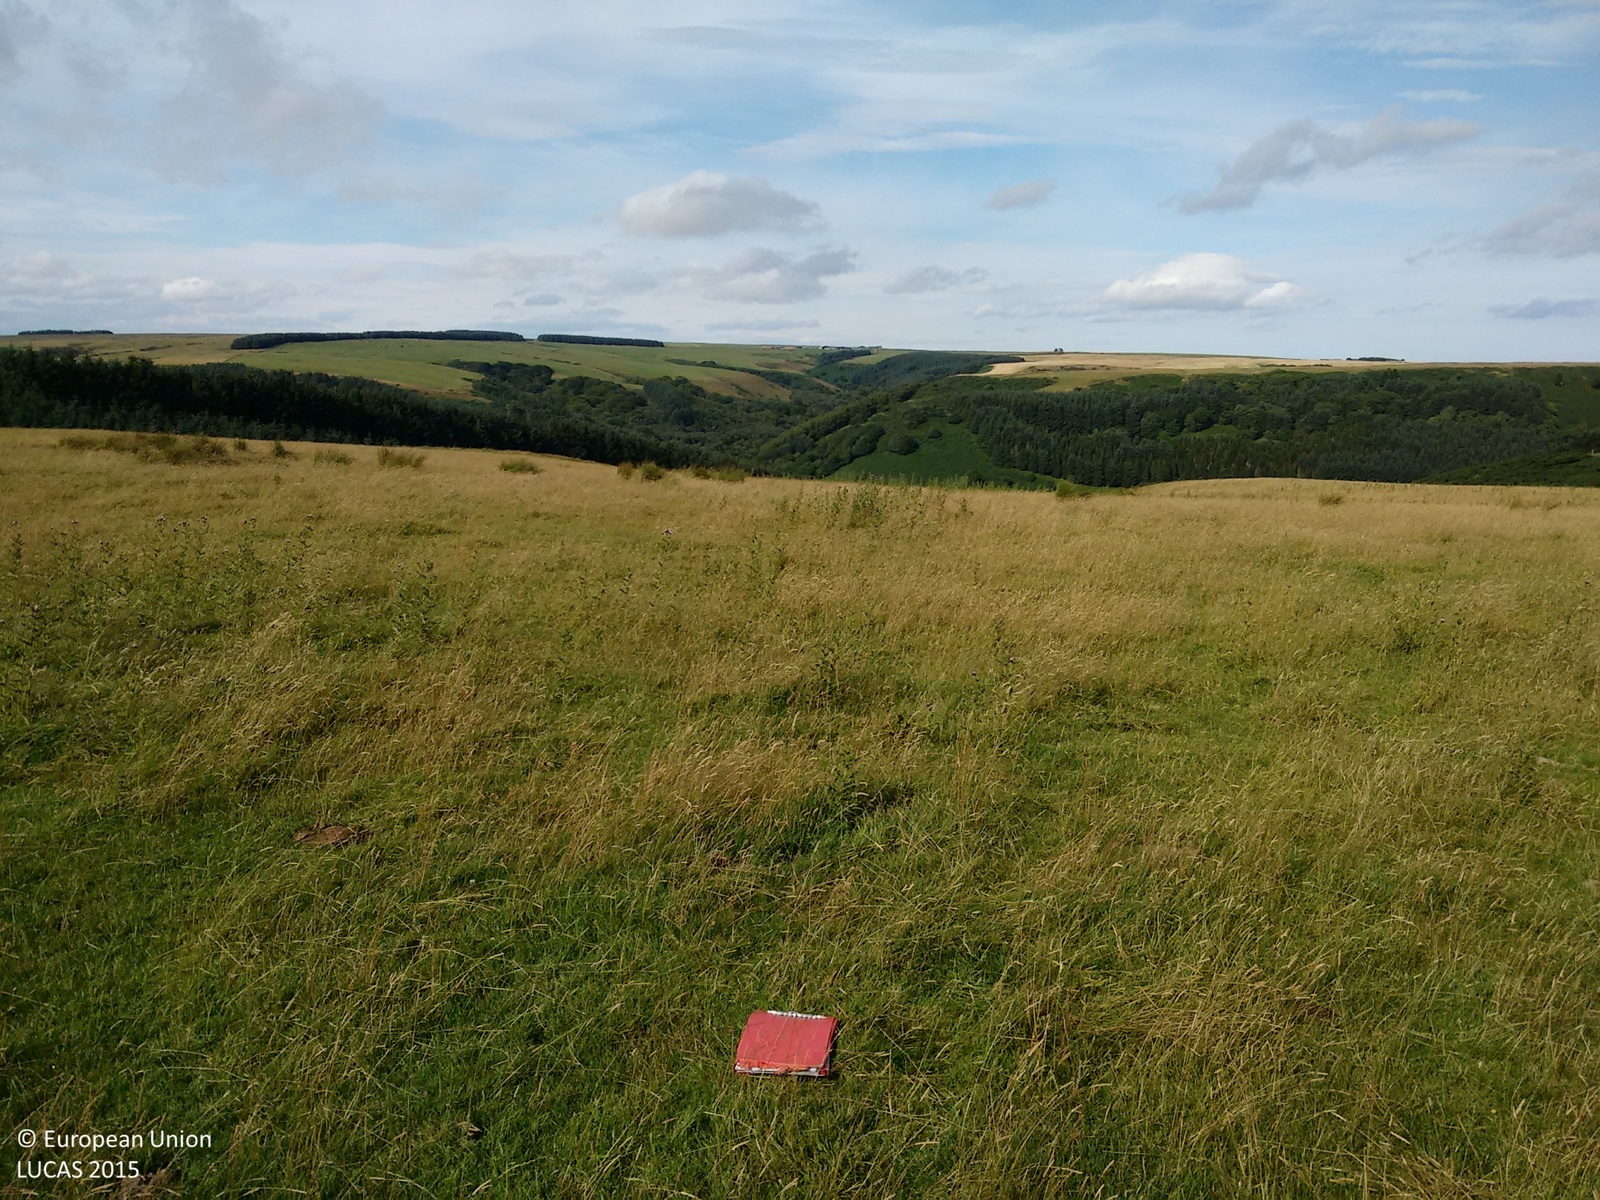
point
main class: Grassland
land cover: Grassland without tree/shrub cover
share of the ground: > 75 %
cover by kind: herbaceous plants 100 %
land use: Agriculture (excluding fallow land and kitchen gardens)
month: August
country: GB
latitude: 57.6551
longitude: -2.2651
